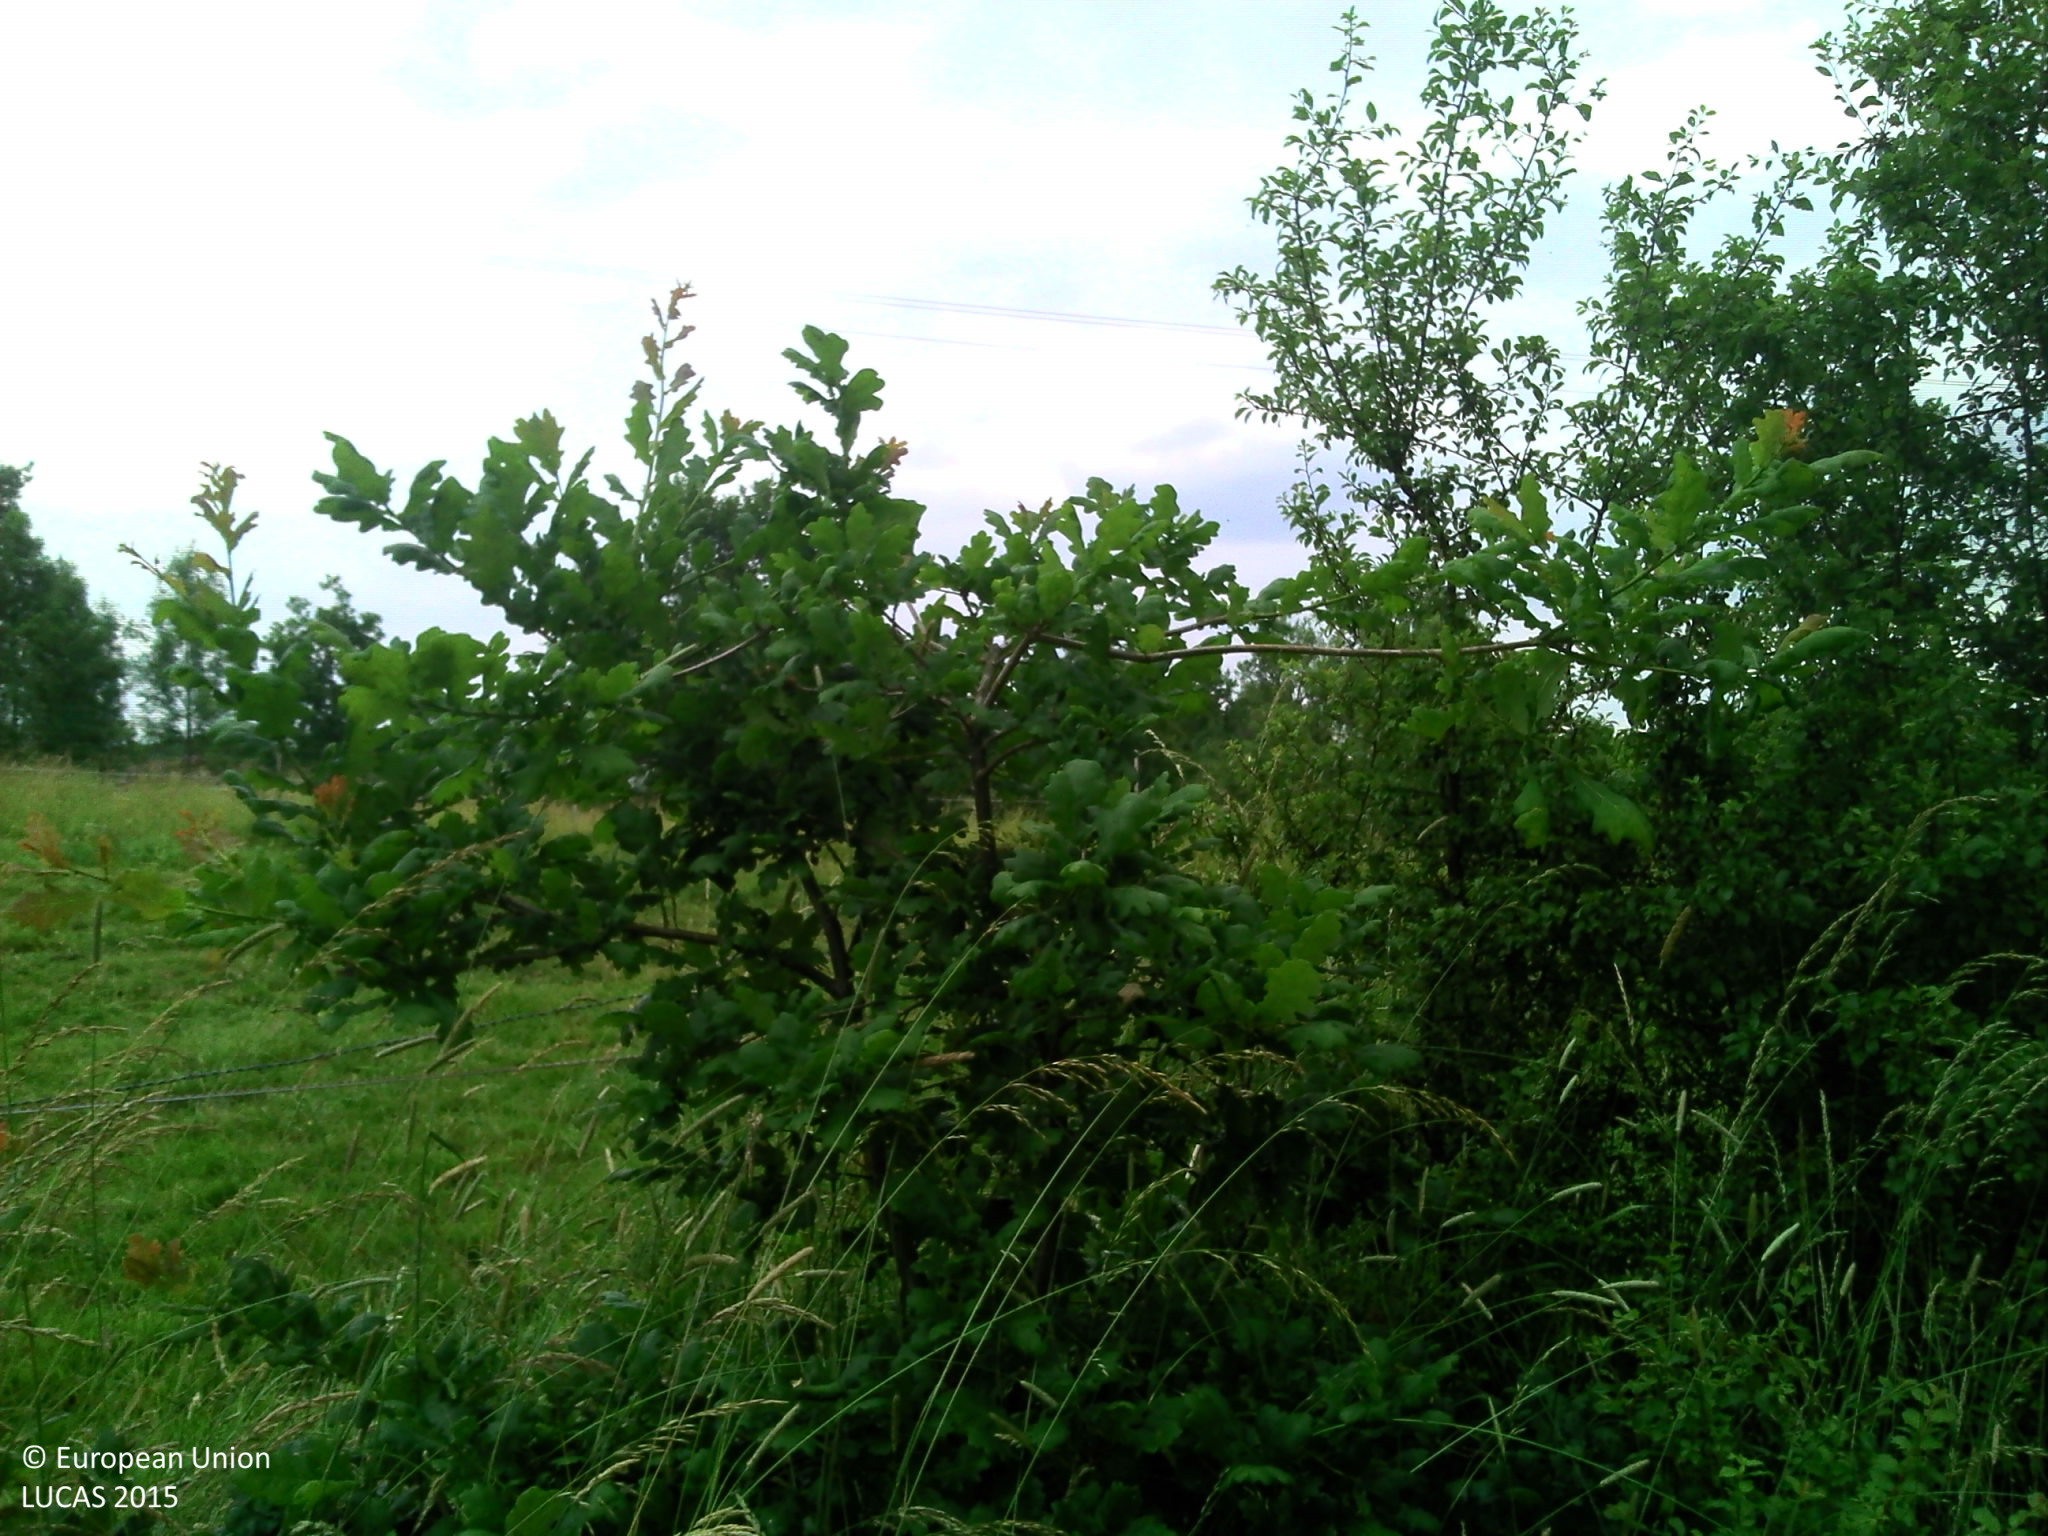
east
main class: Grassland
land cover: Grassland with sparse tree/shrub cover
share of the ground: > 75 %
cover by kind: herbaceous plants 95 %, broadleaved forest trees 5 %
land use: Agriculture (excluding fallow land and kitchen gardens)
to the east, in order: Grassland with sparse tree/shrub cover; Fences; Grassland without tree/shrub cover; Fences; Grassland without tree/shrub cover; Fences; Broadleaved woodland; Grassland without tree/shrub cover; Broadleaved woodland; Artificial constructions in urban areas
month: June
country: FR
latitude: 48.6876
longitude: 5.0129
